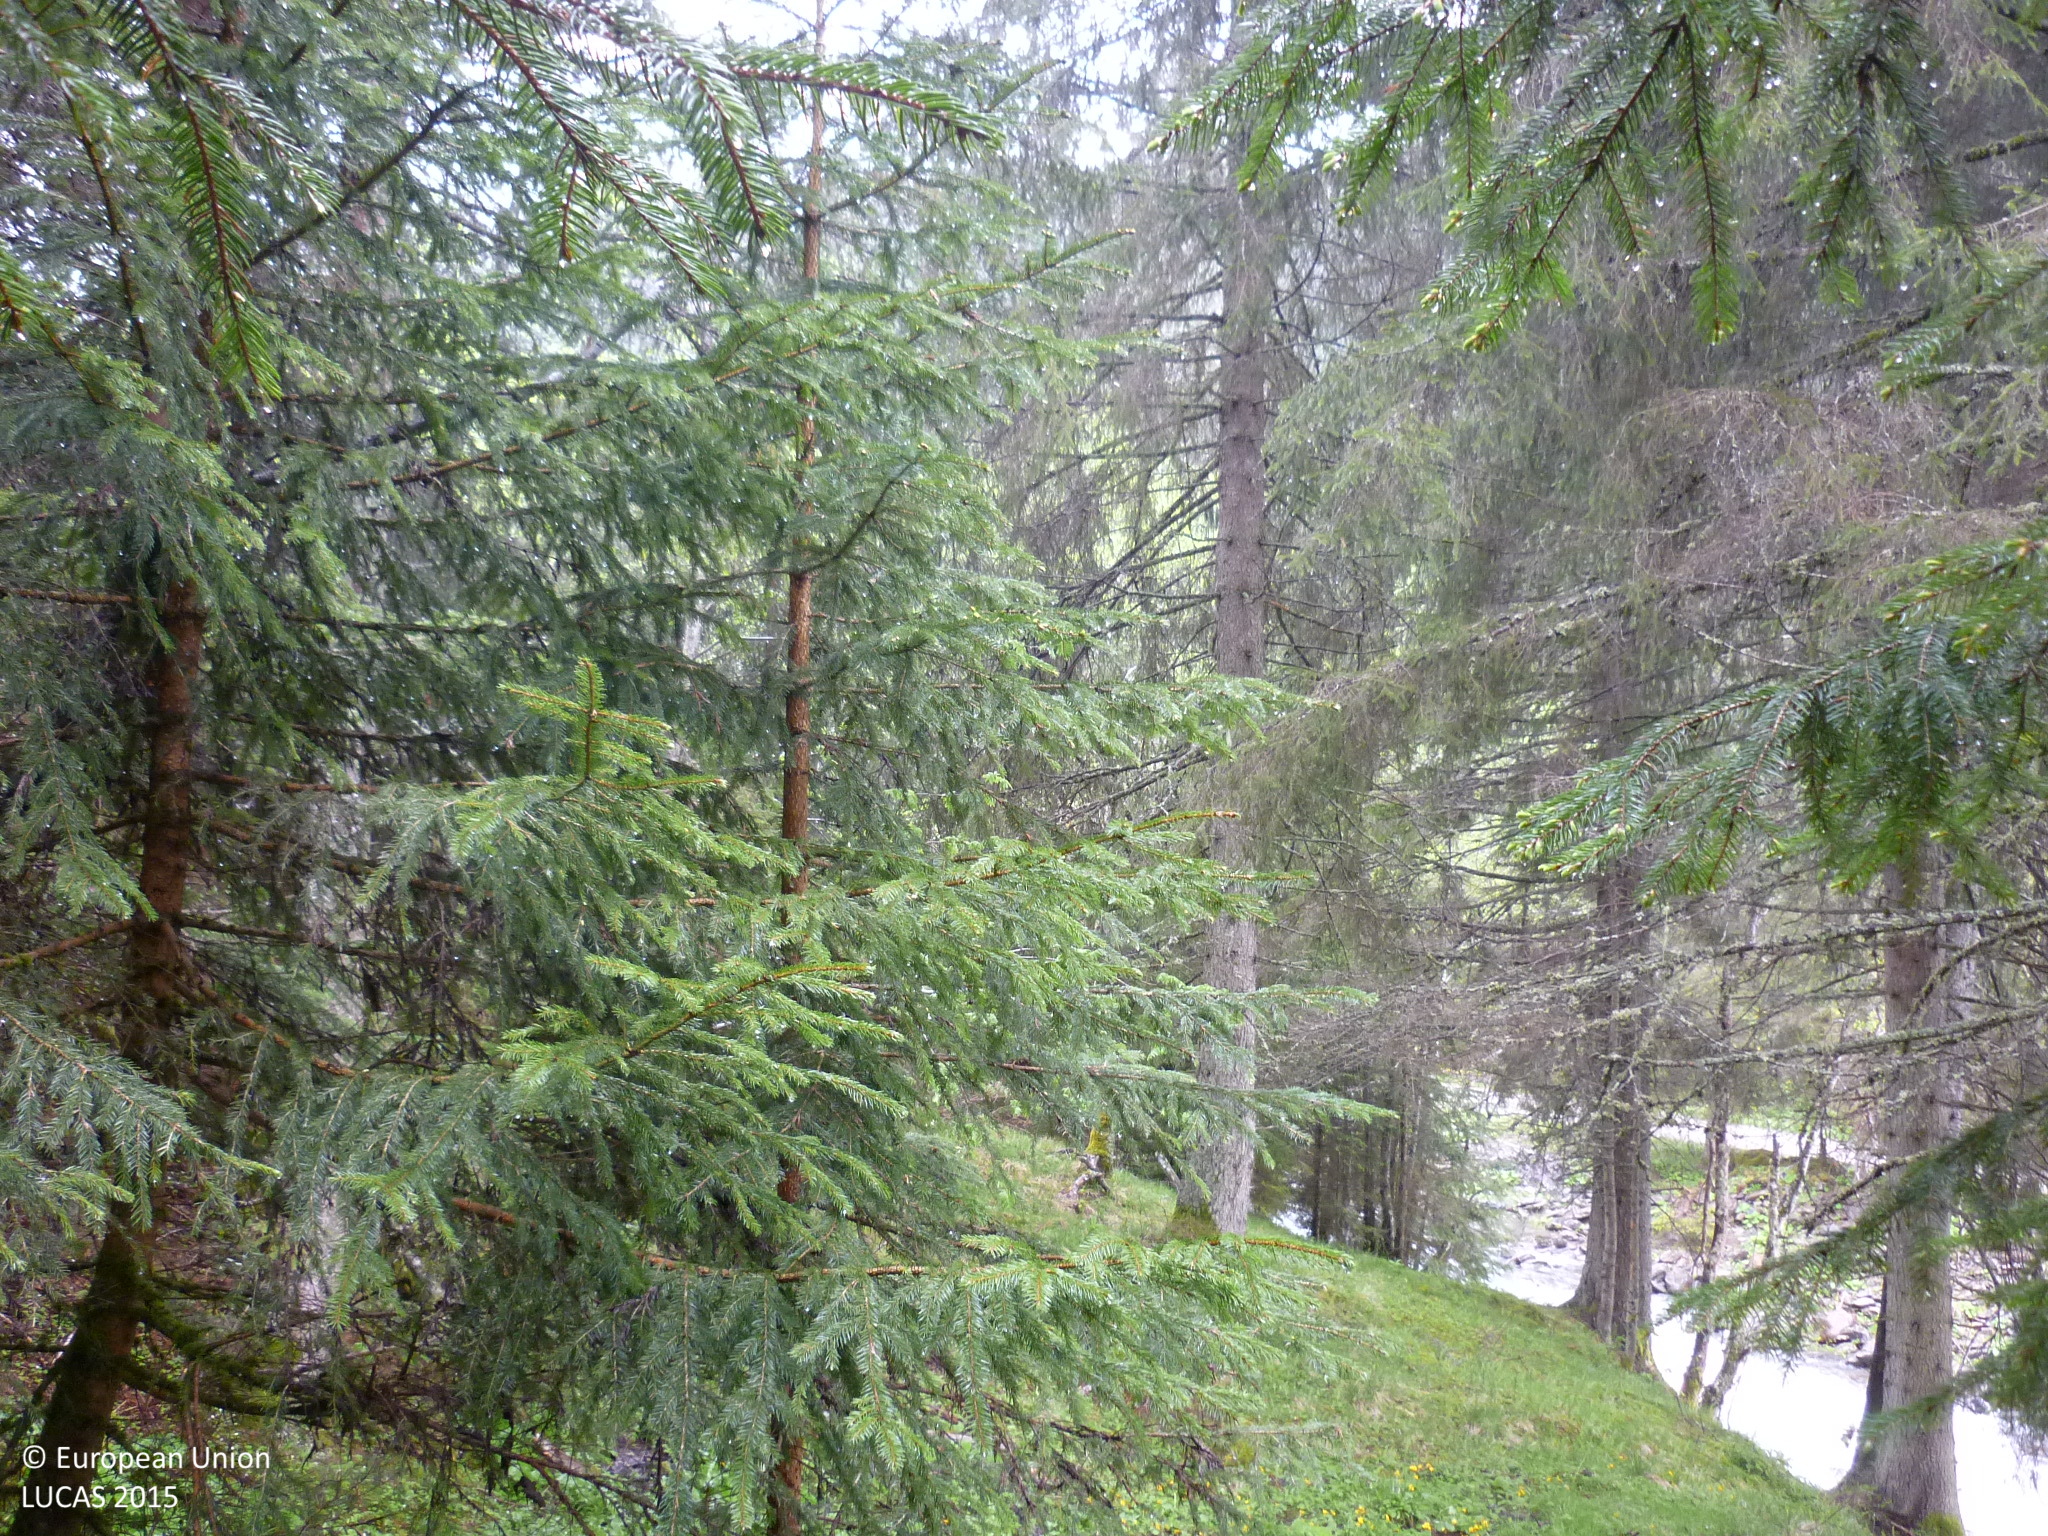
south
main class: Woodland
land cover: Spruce dominated coniferous woodland
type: alpine coniferous forest
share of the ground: > 75 %
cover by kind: coniferous forest trees 70 %, broadleaved forest trees 15 %, herbaceous plants 15 %
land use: Forestry
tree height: > 5 m
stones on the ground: < 10 %
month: May
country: AT
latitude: 47.3518
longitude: 14.1686
